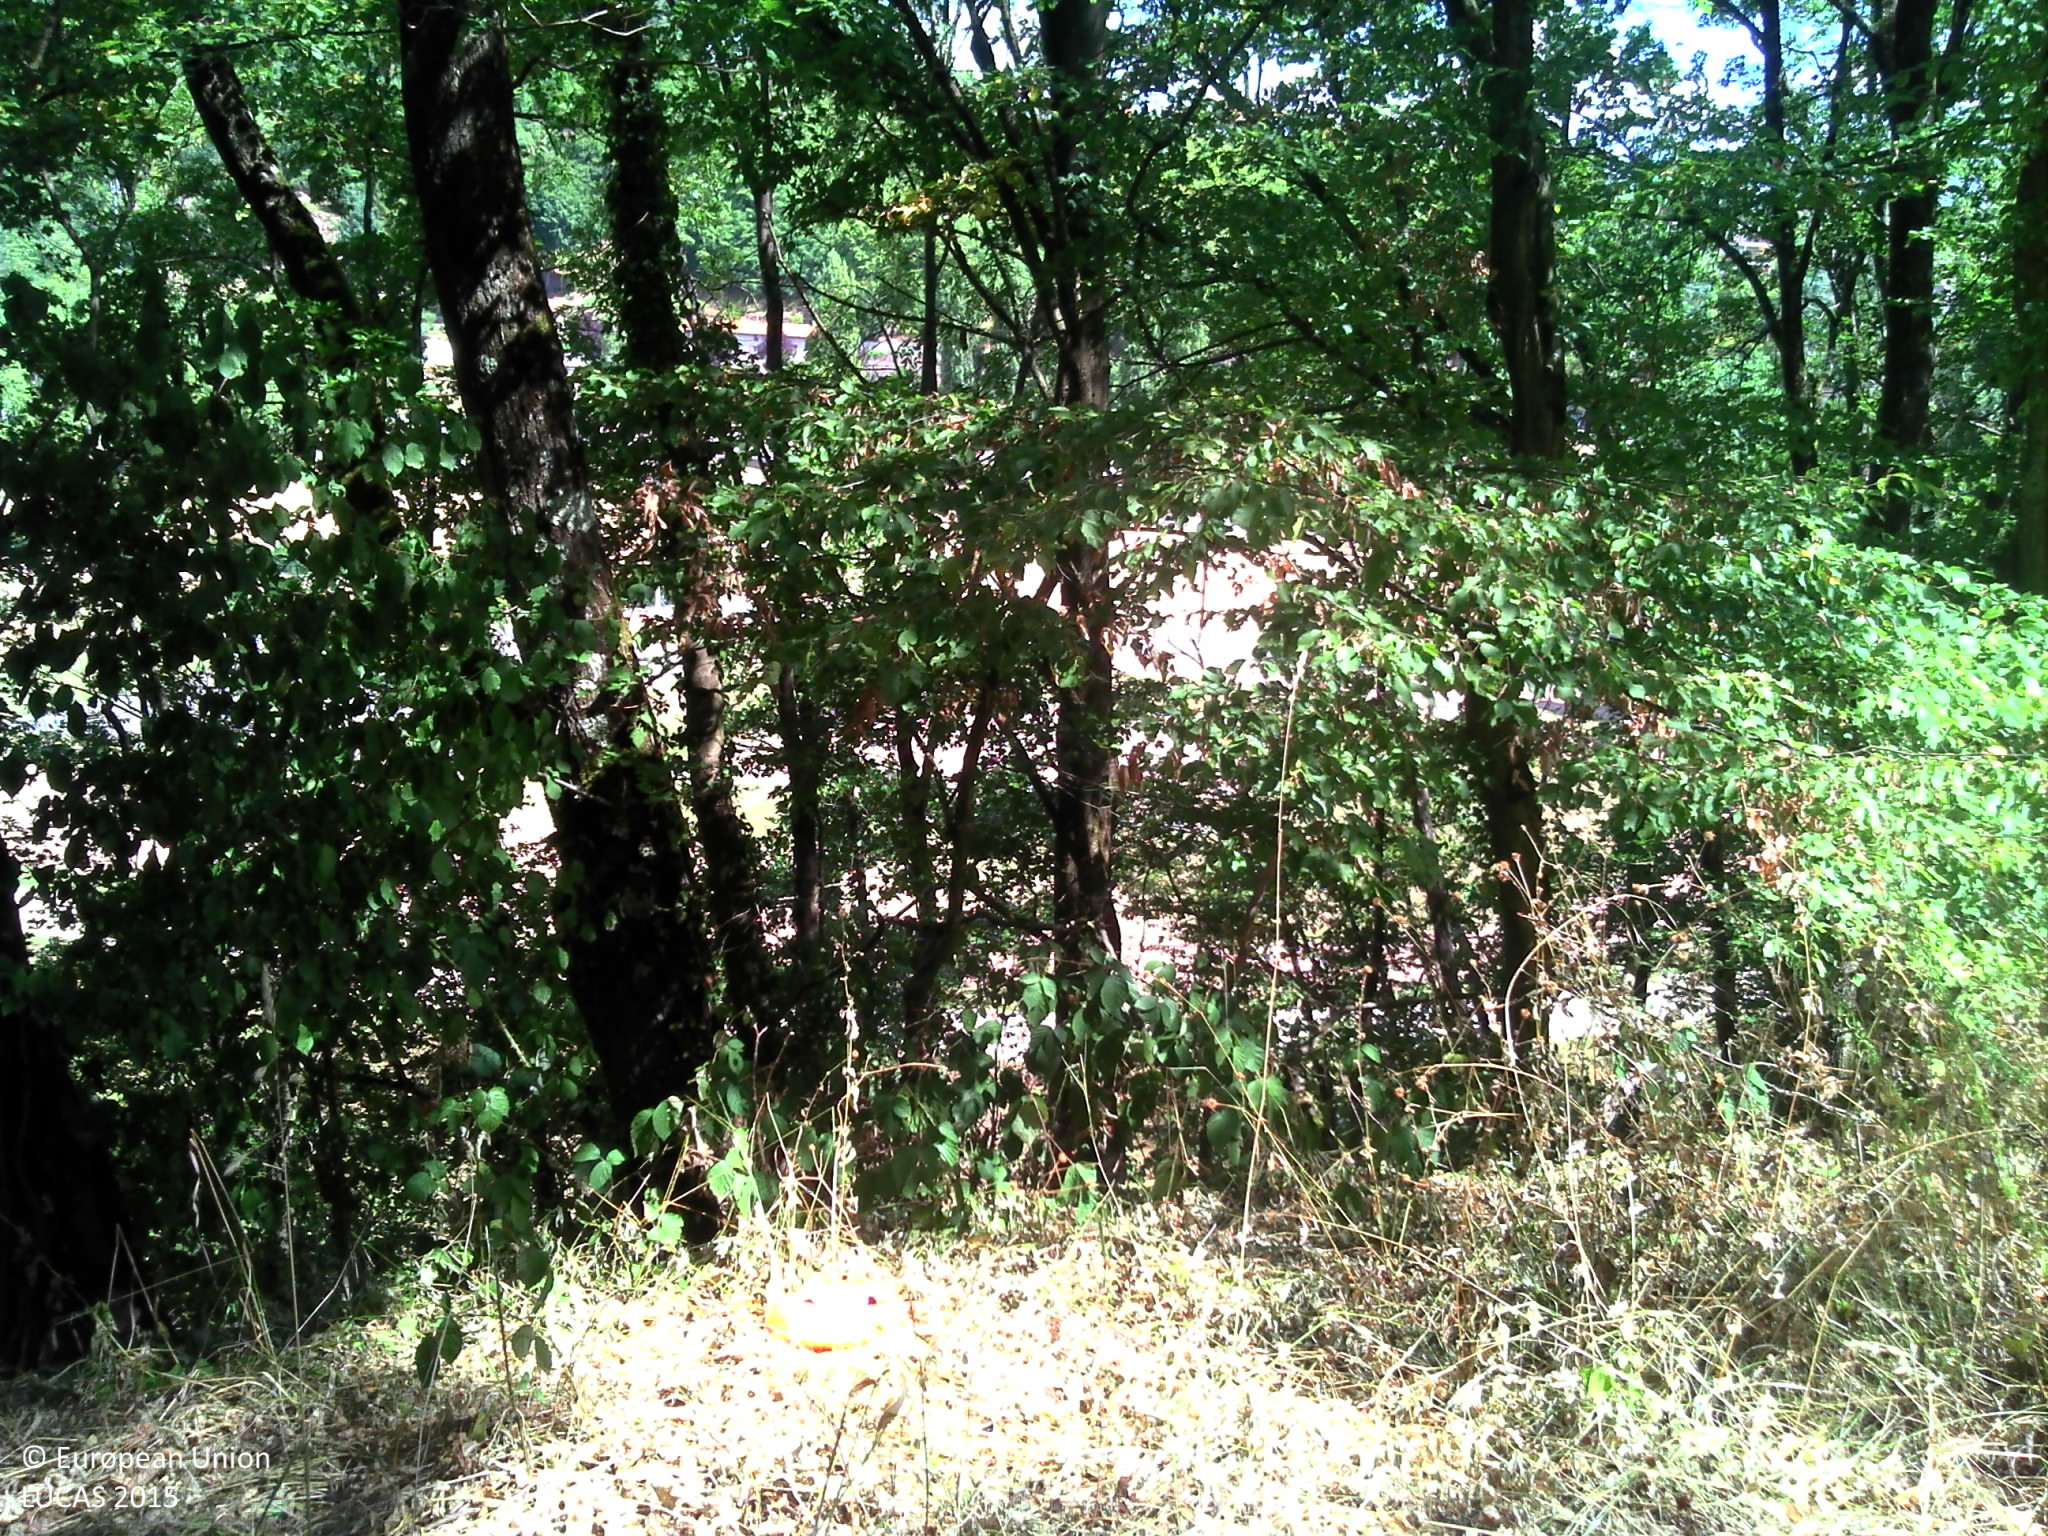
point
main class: Woodland
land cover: Broadleaved woodland
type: mesophytic deciduous forest
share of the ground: > 75 %
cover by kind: broadleaved forest trees 100 %
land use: Community services
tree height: > 5 m
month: July
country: FR
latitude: 45.8362
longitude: 4.6087
